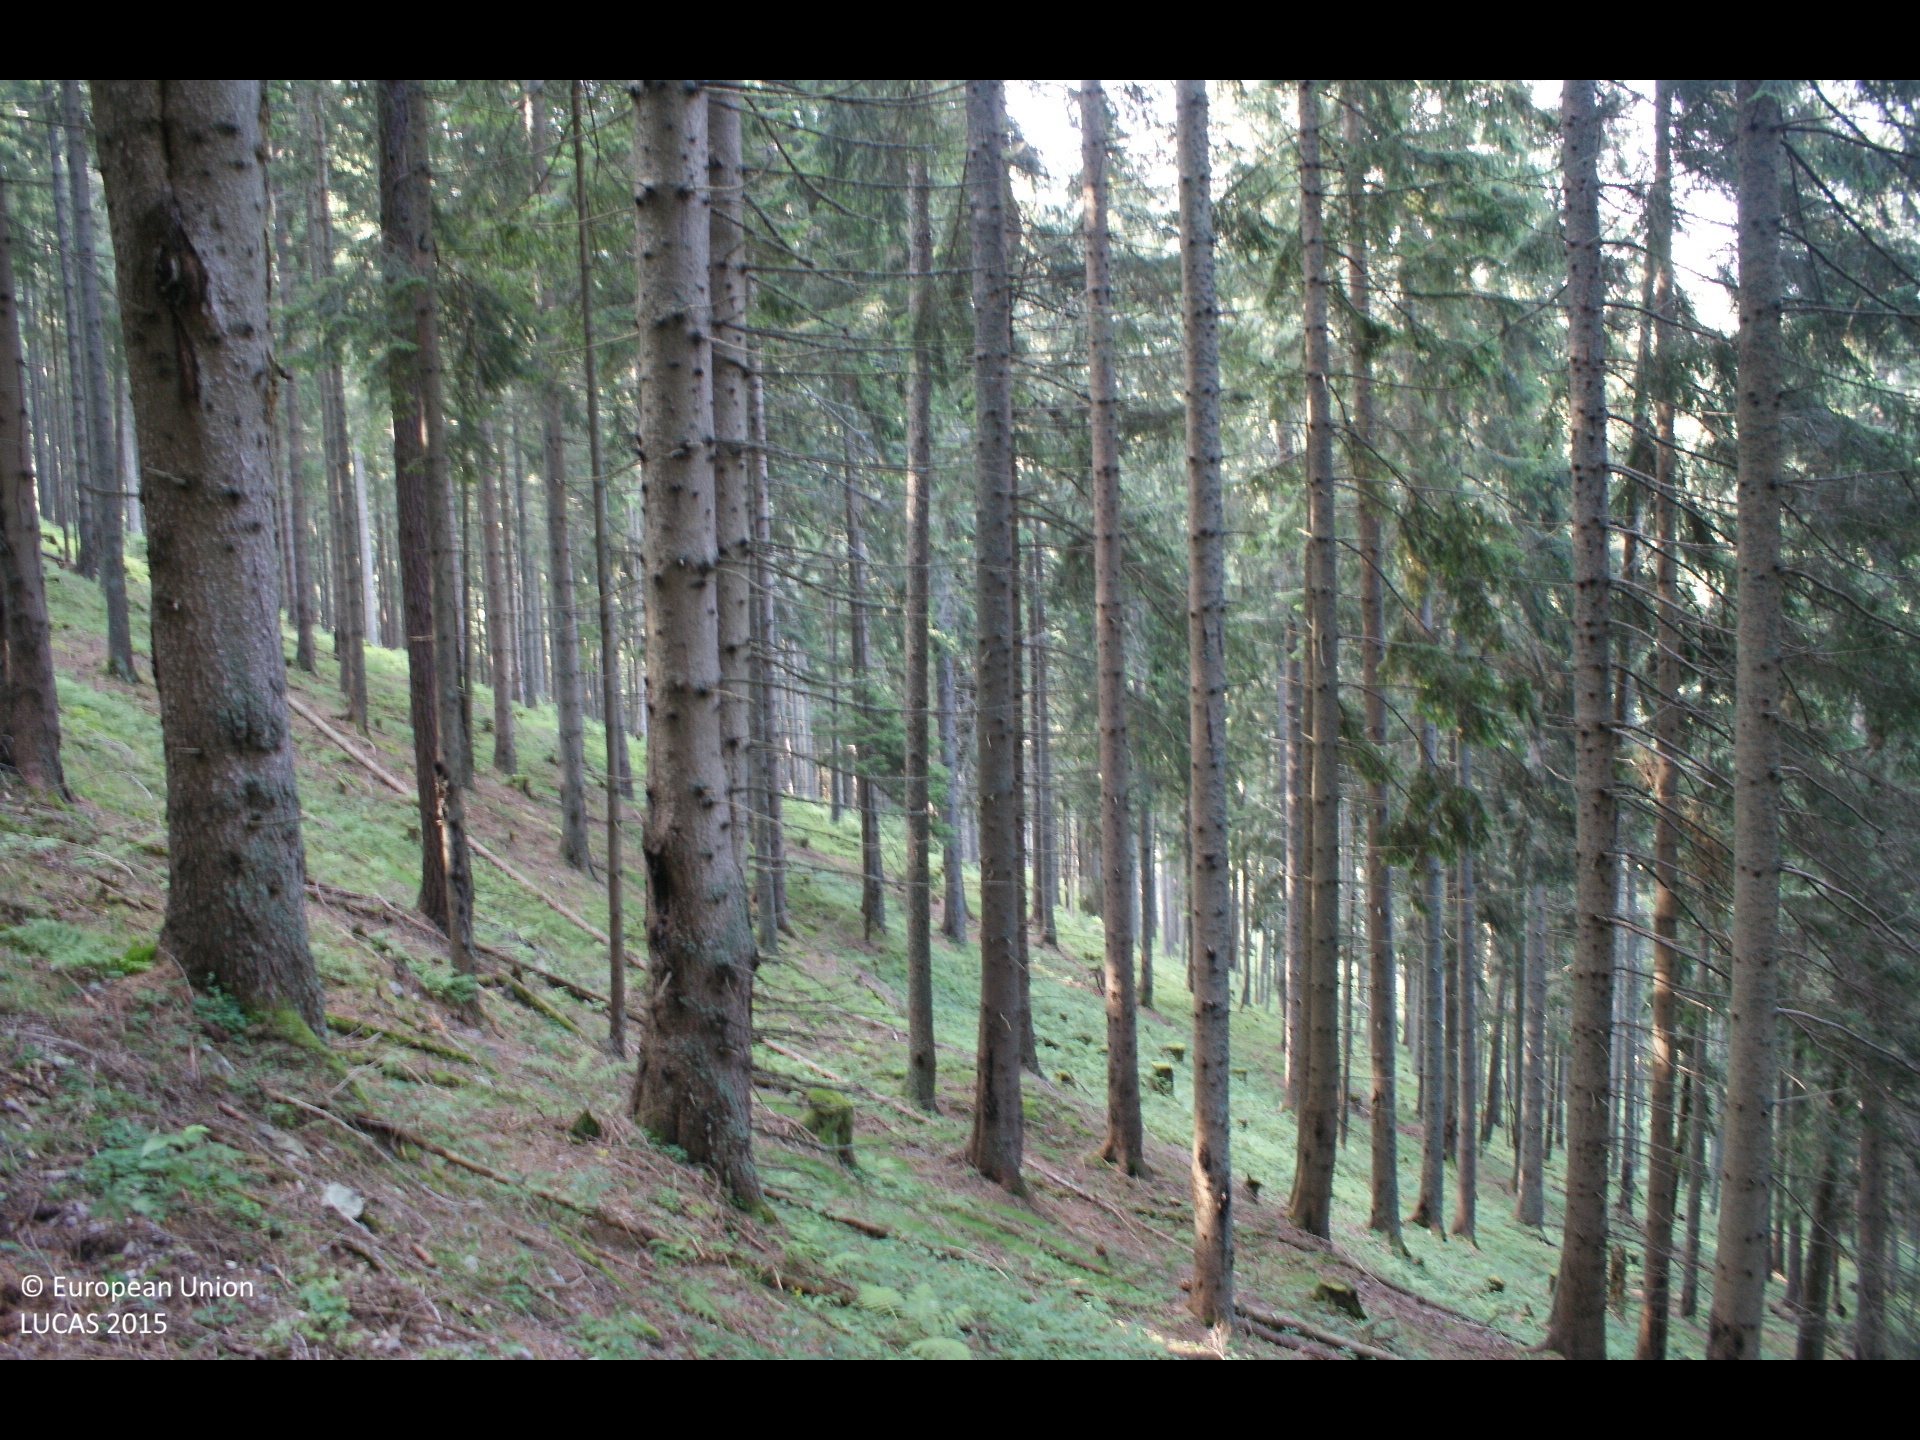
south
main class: Woodland
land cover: Spruce dominated coniferous woodland
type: alpine coniferous forest
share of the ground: > 75 %
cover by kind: coniferous forest trees 85 %, shrubs 5 %, herbaceous plants 5 %, lichens and mosses 5 %
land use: Forestry
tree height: > 5 m
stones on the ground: > 50 %
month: August
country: AT
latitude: 47.6446
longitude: 15.3122
